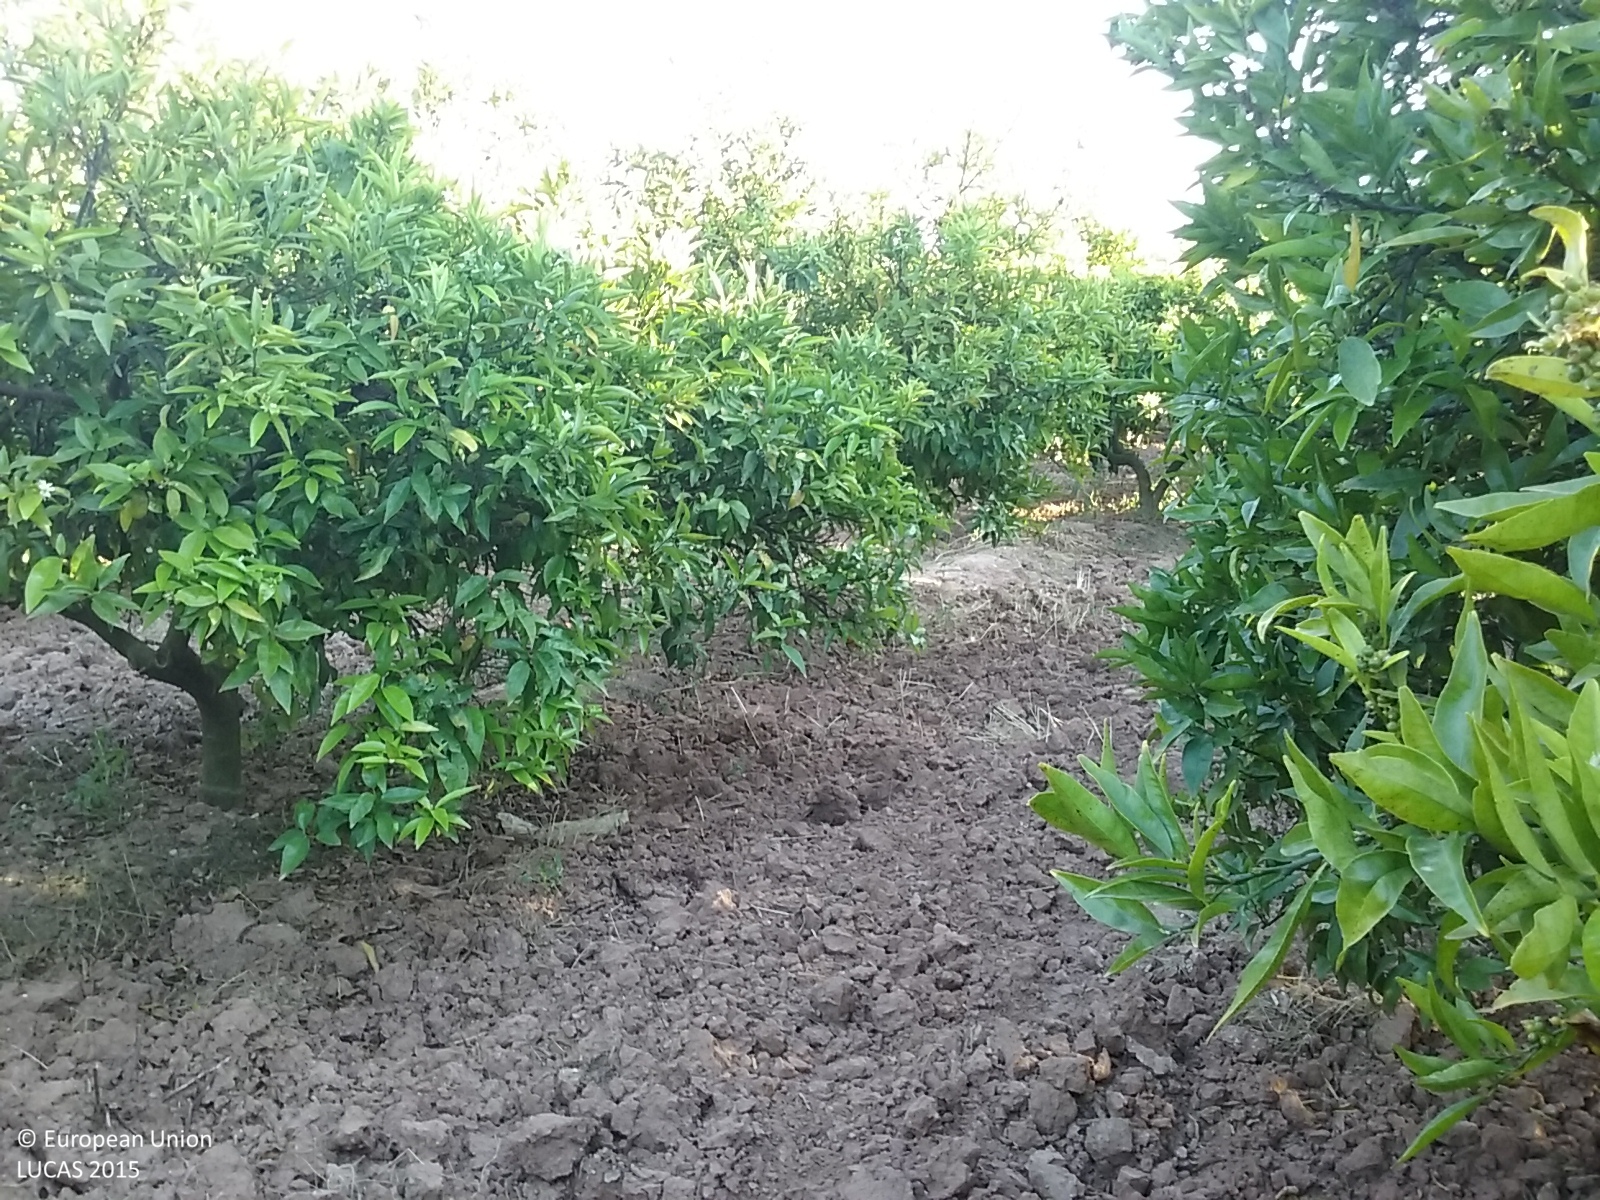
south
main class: Cropland
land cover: Other citrus fruit
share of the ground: 50 - 75 %
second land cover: Other bare soil
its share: > 75 %
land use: Agriculture (excluding fallow land and kitchen gardens)
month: May
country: ES
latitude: 39.9343
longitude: -0.0291
